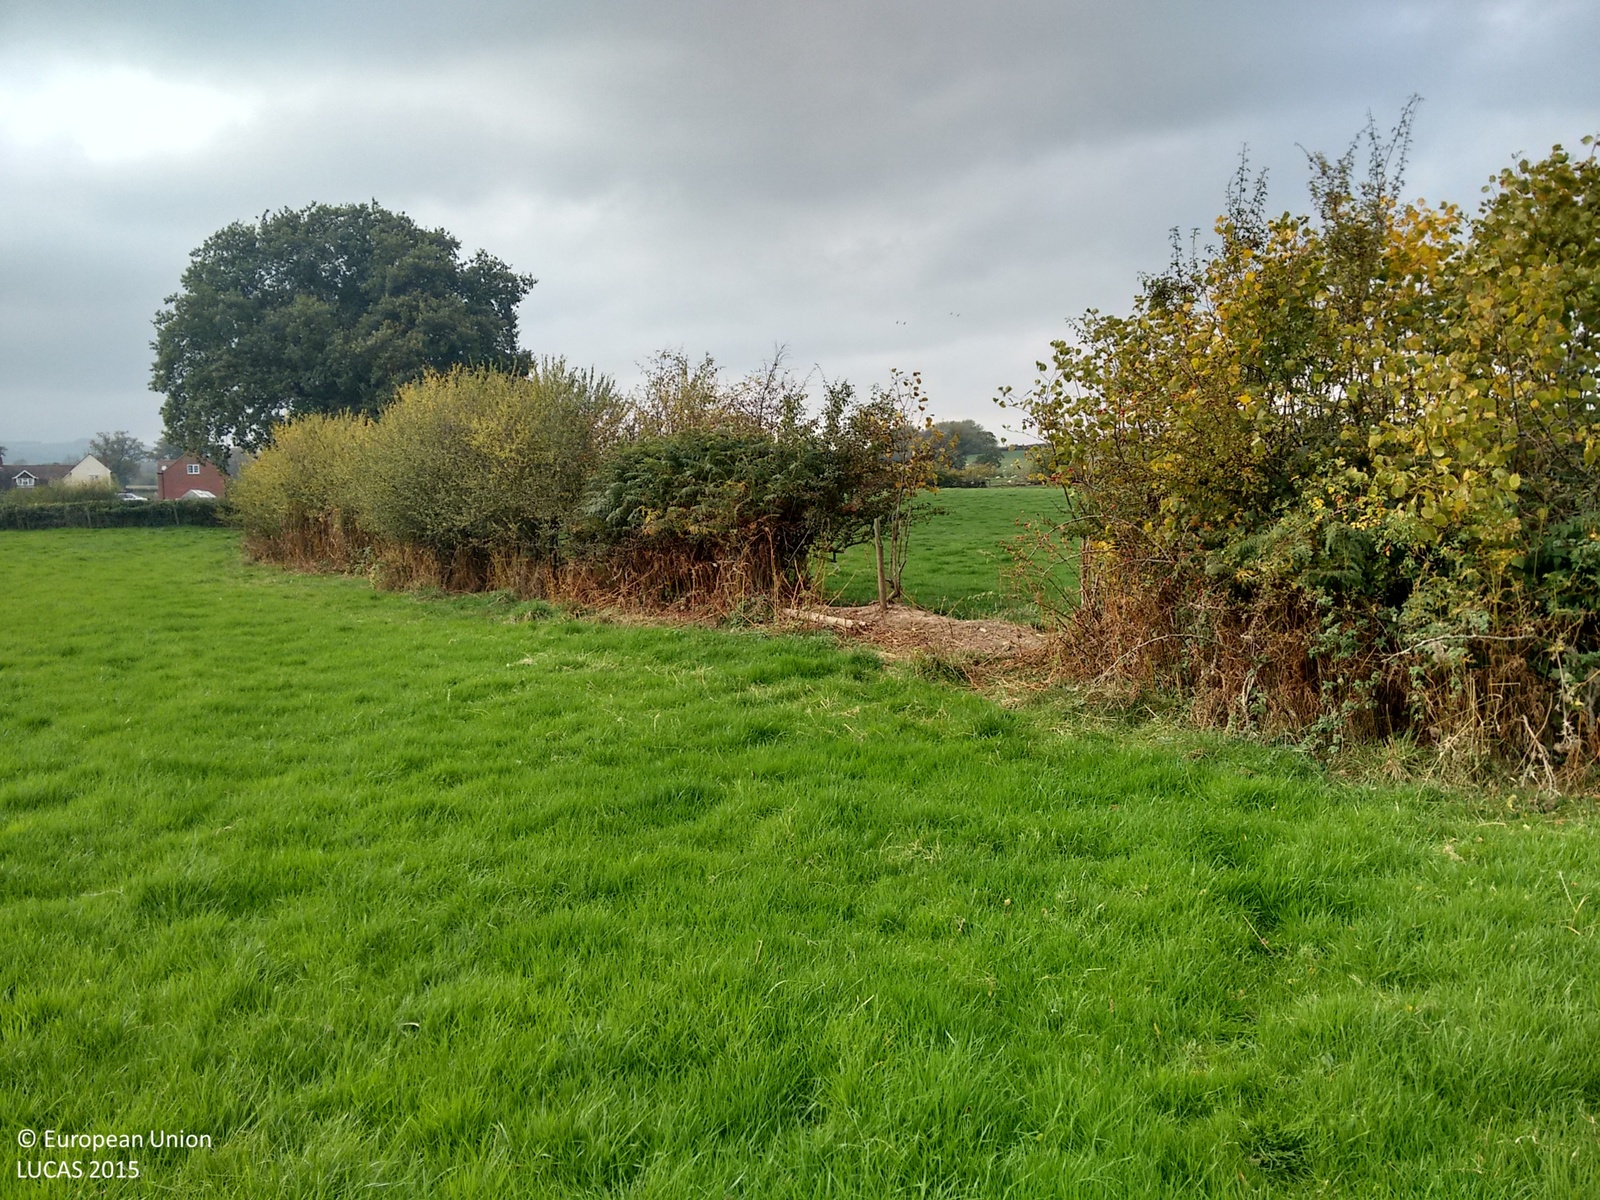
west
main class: Grassland
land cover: Grassland without tree/shrub cover
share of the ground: > 75 %
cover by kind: herbaceous plants 100 %
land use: Agriculture (excluding fallow land and kitchen gardens)
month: October
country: GB
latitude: 52.5936
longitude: -2.7813
